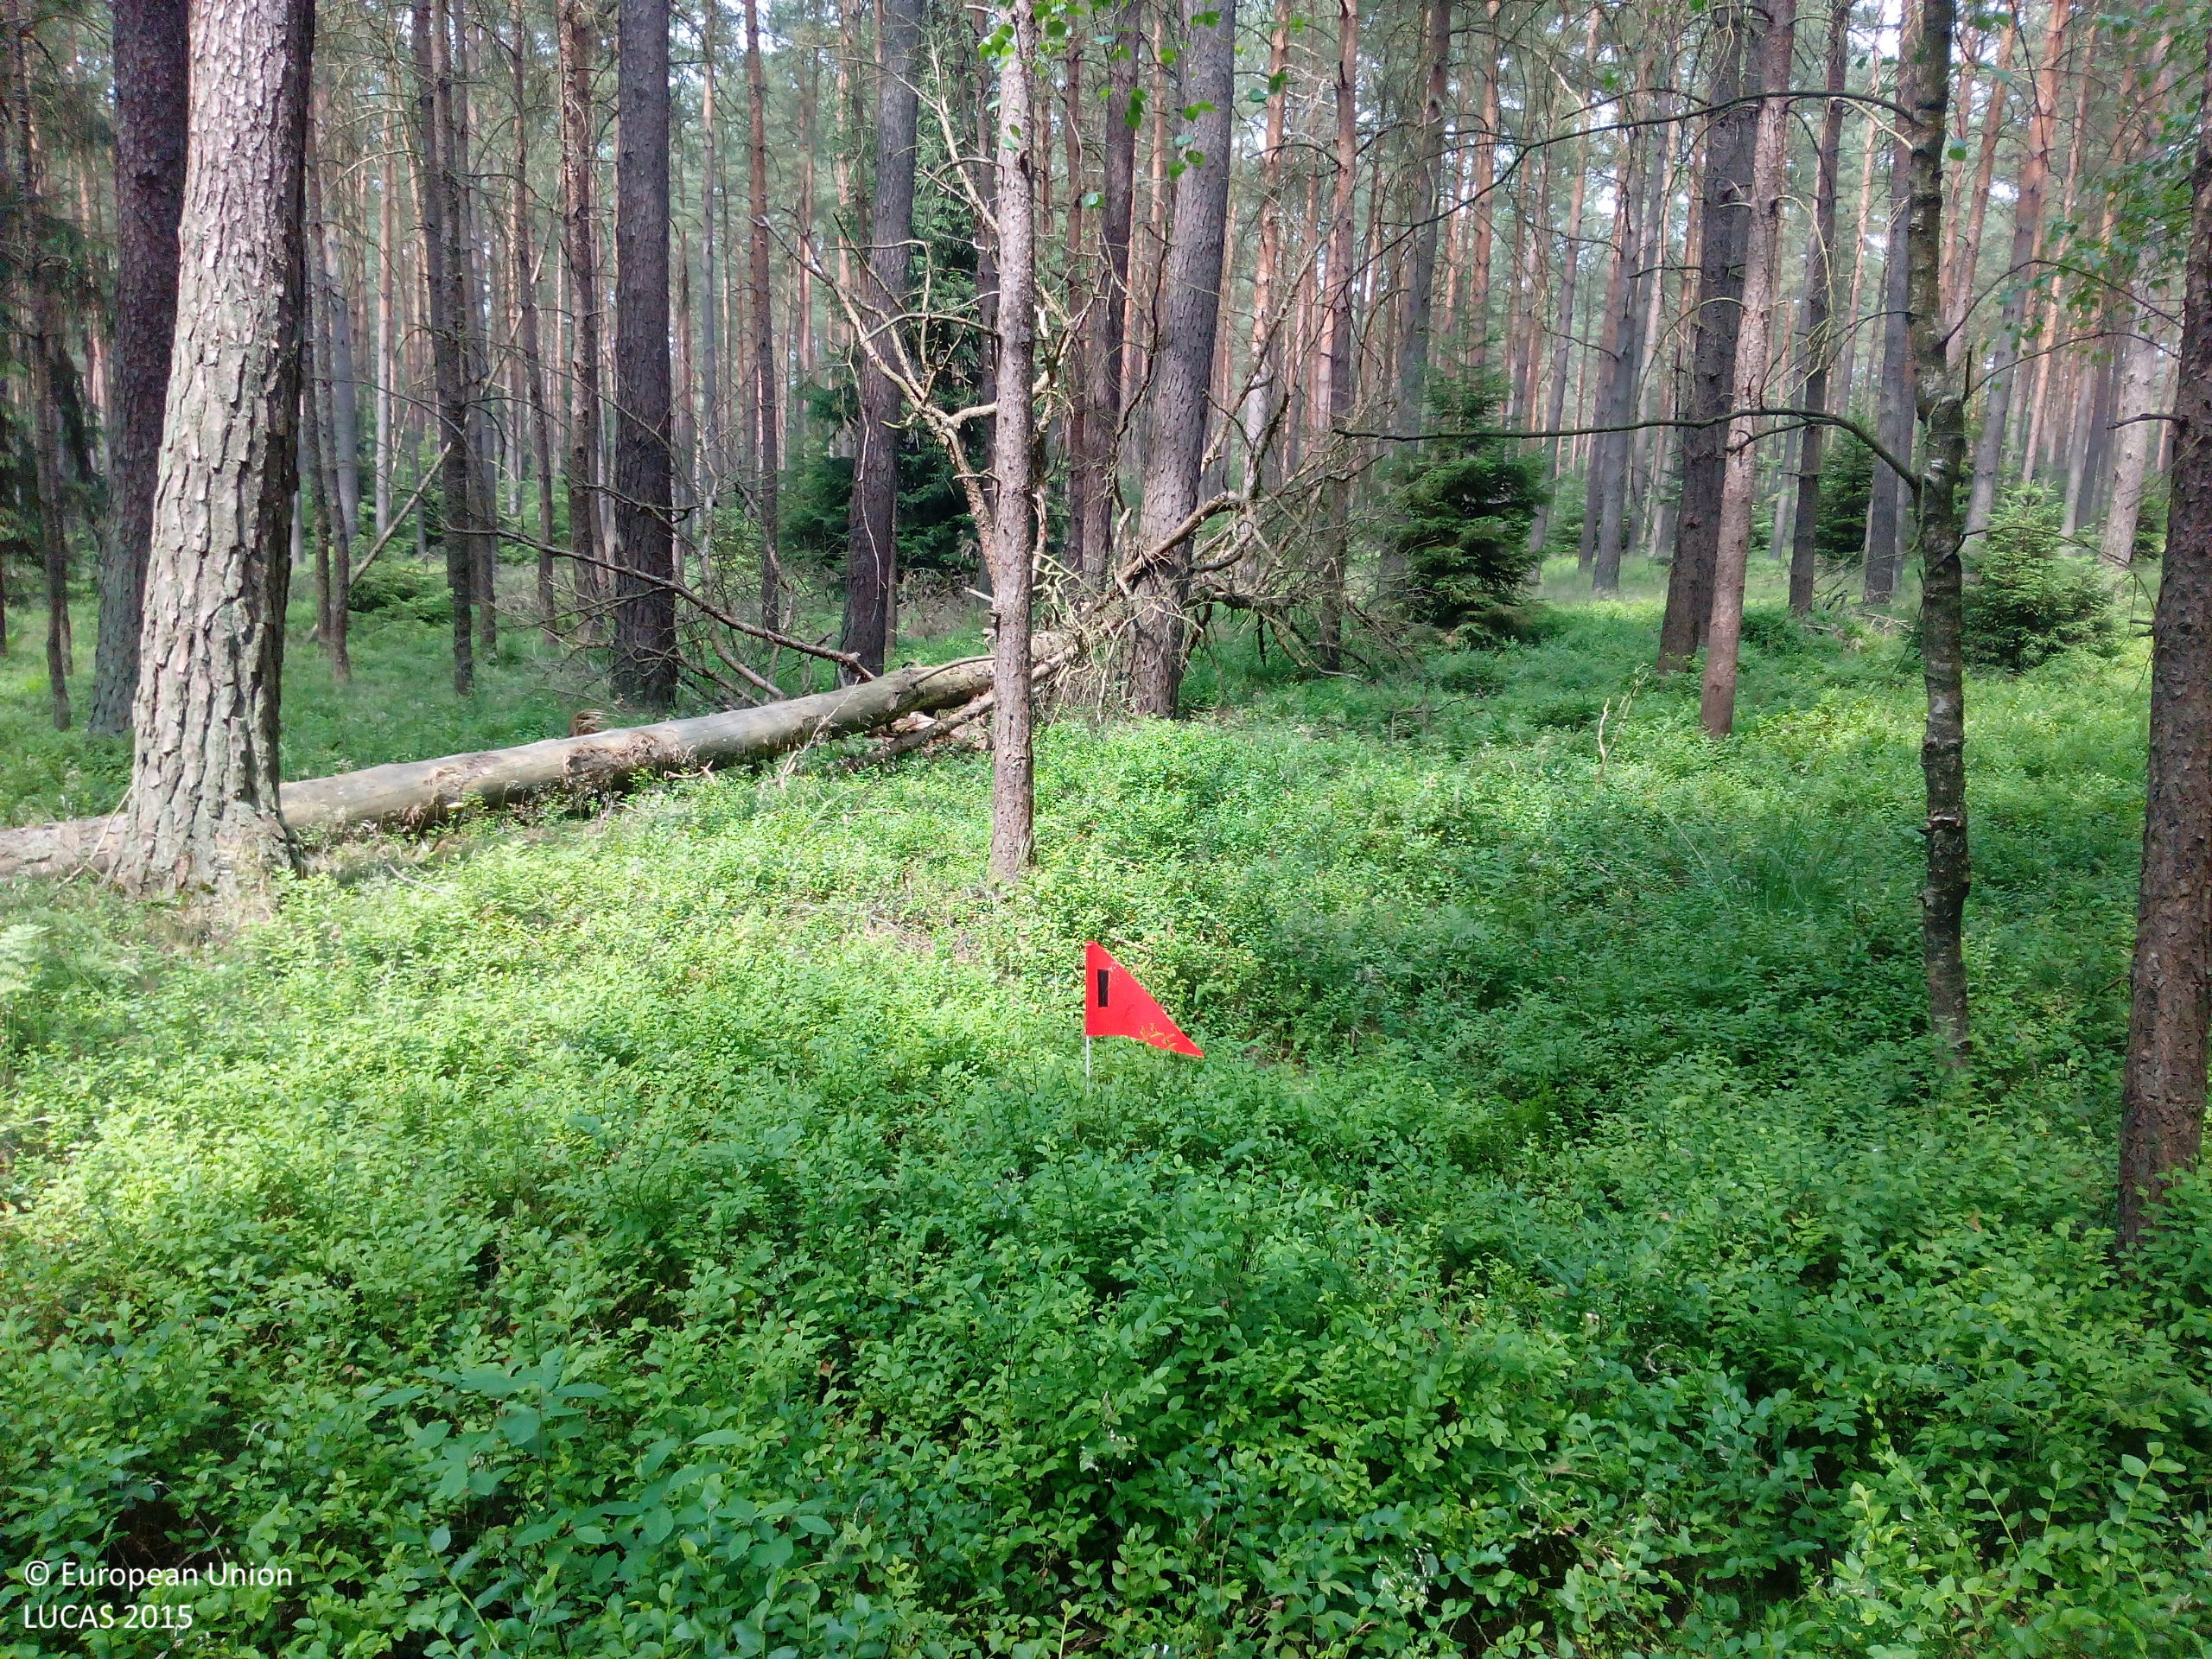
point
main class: Woodland
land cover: Pine dominated coniferous woodland
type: hemiboreal forest and nemoral coniferous forest and mixed broadleaved-coniferous forest
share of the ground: > 75 %
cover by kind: coniferous forest trees 75 %, broadleaved forest trees 15 %, shrubs 10 %
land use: Forestry
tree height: > 5 m
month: July
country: DE
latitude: 52.7546
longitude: 10.2814
